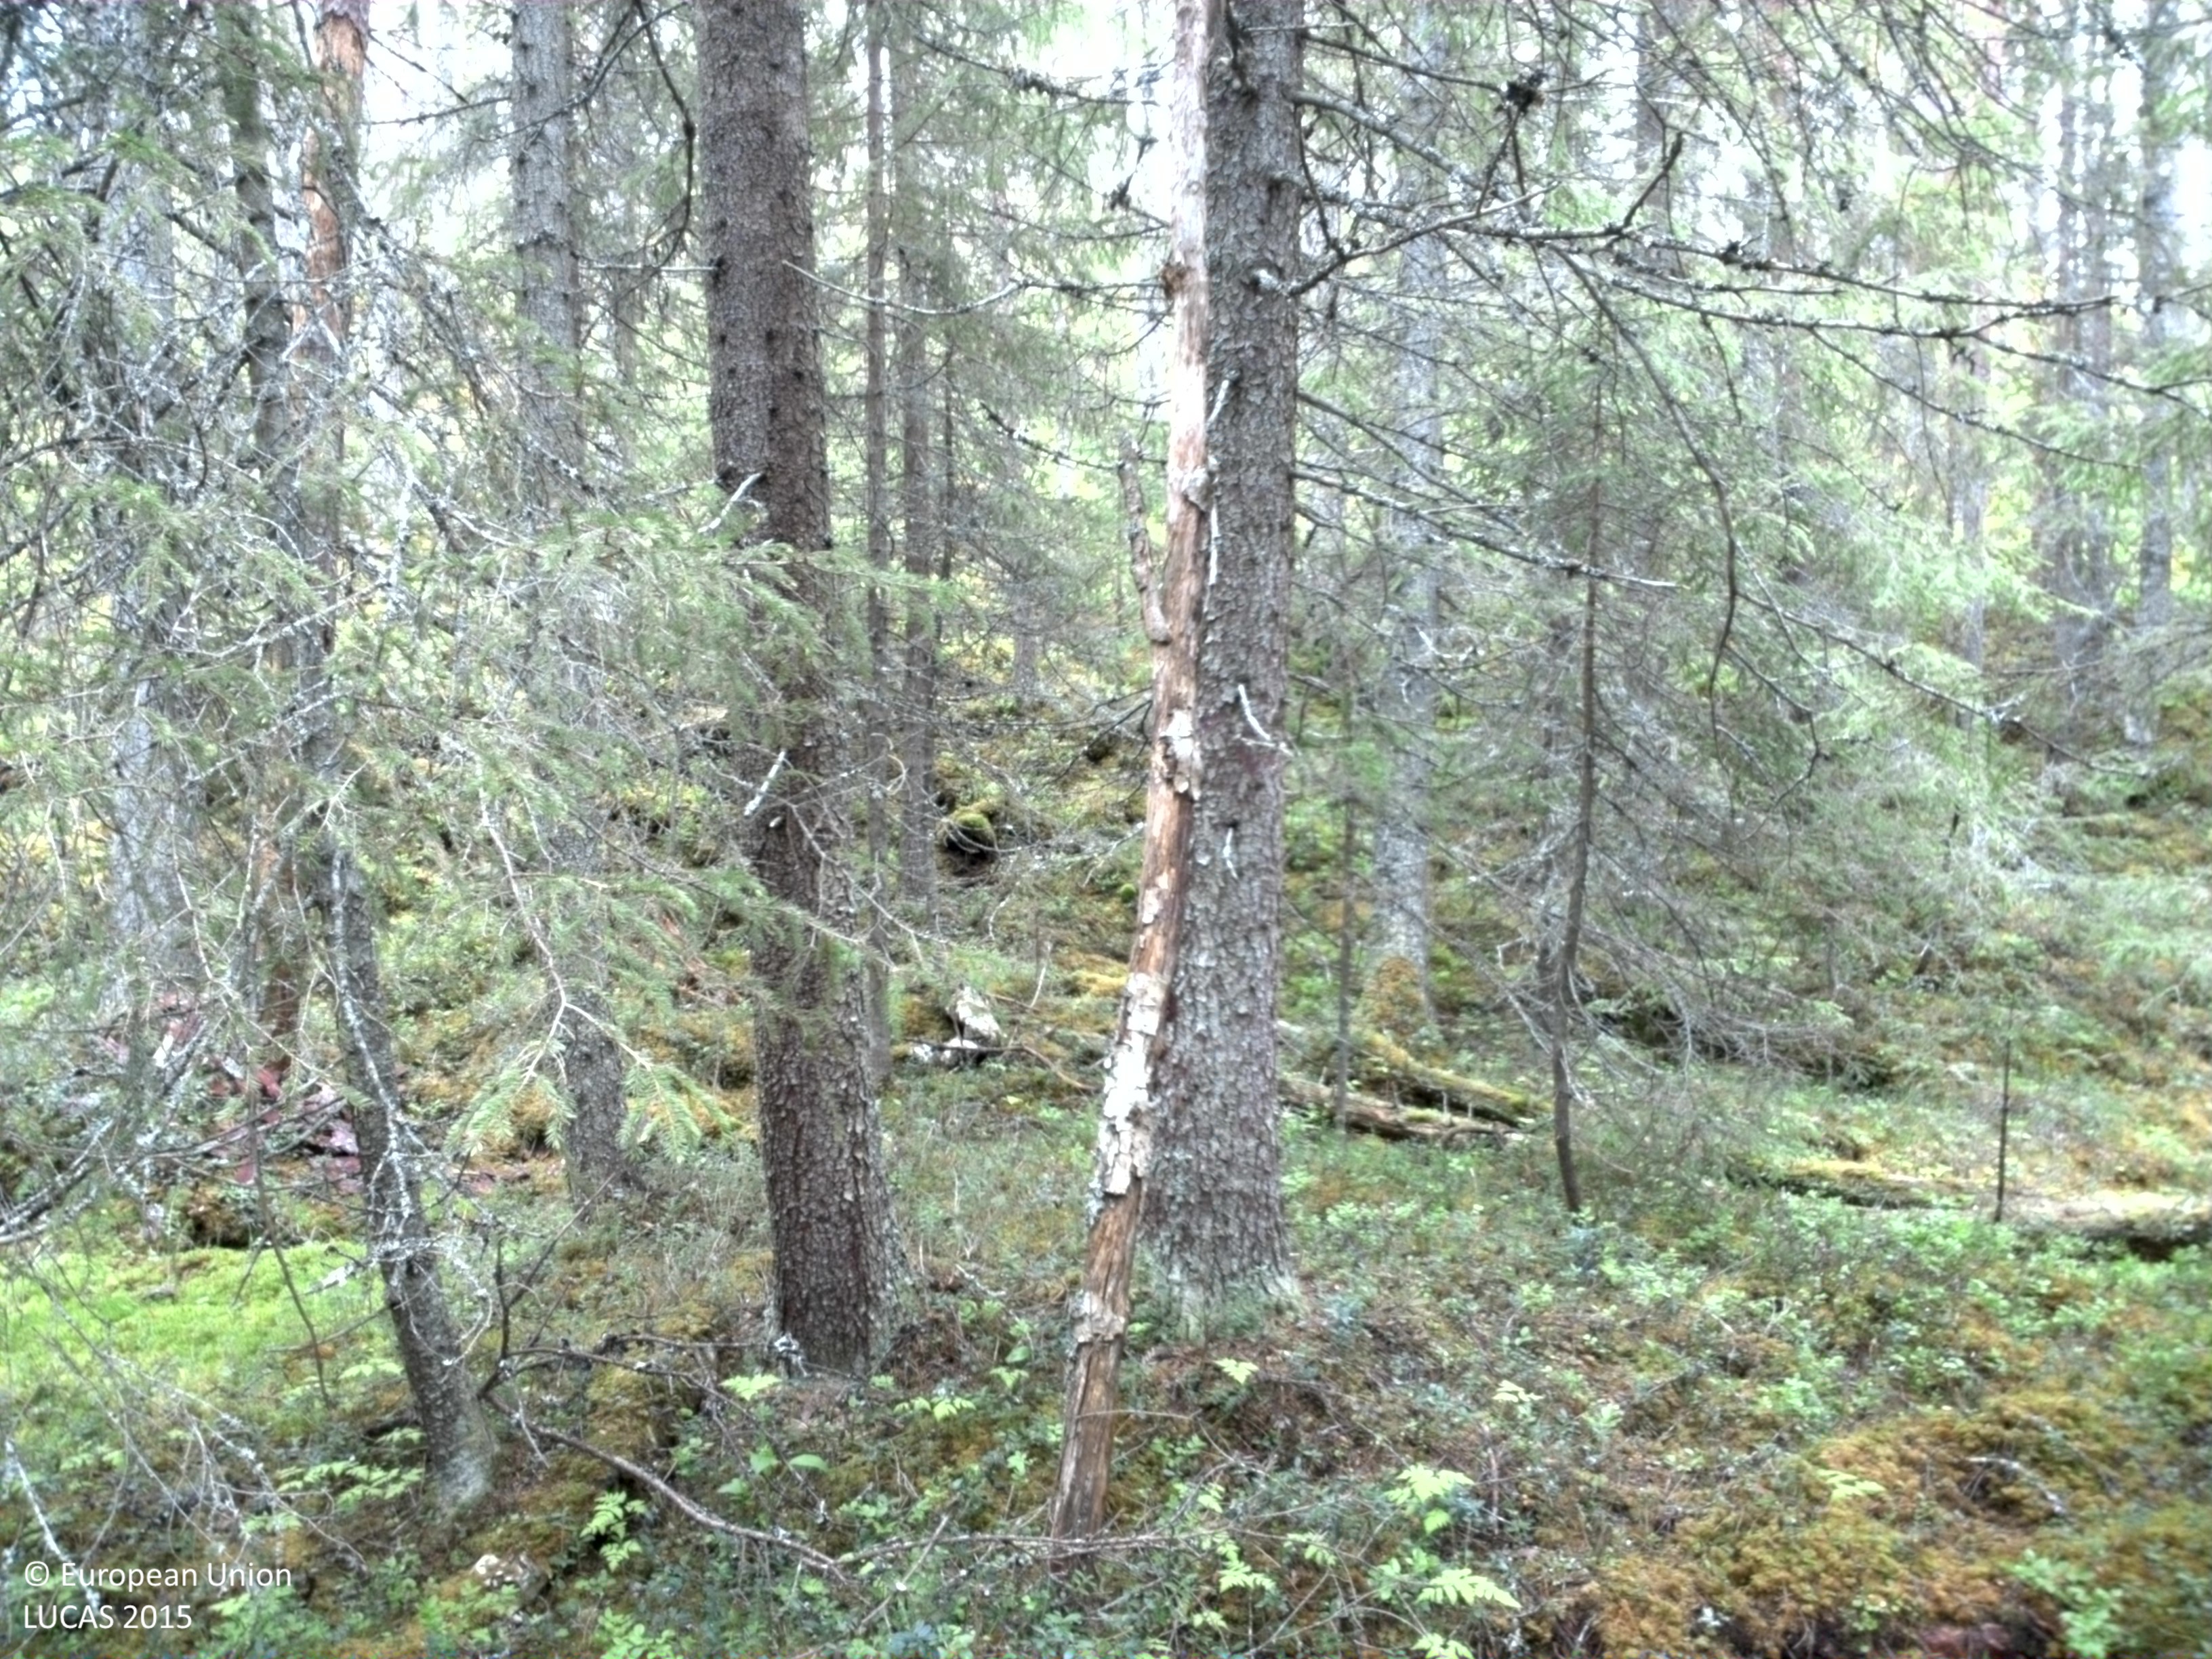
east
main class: Woodland
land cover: Spruce dominated coniferous woodland
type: boreal forest
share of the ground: > 75 %
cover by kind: coniferous forest trees 80 %, shrubs 10 %, lichens and mosses 10 %
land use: Forestry
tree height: > 5 m
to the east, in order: Spruce dominated coniferous woodland; Pine dominated coniferous woodland
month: June
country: SE
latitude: 62.2259
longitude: 13.6206
